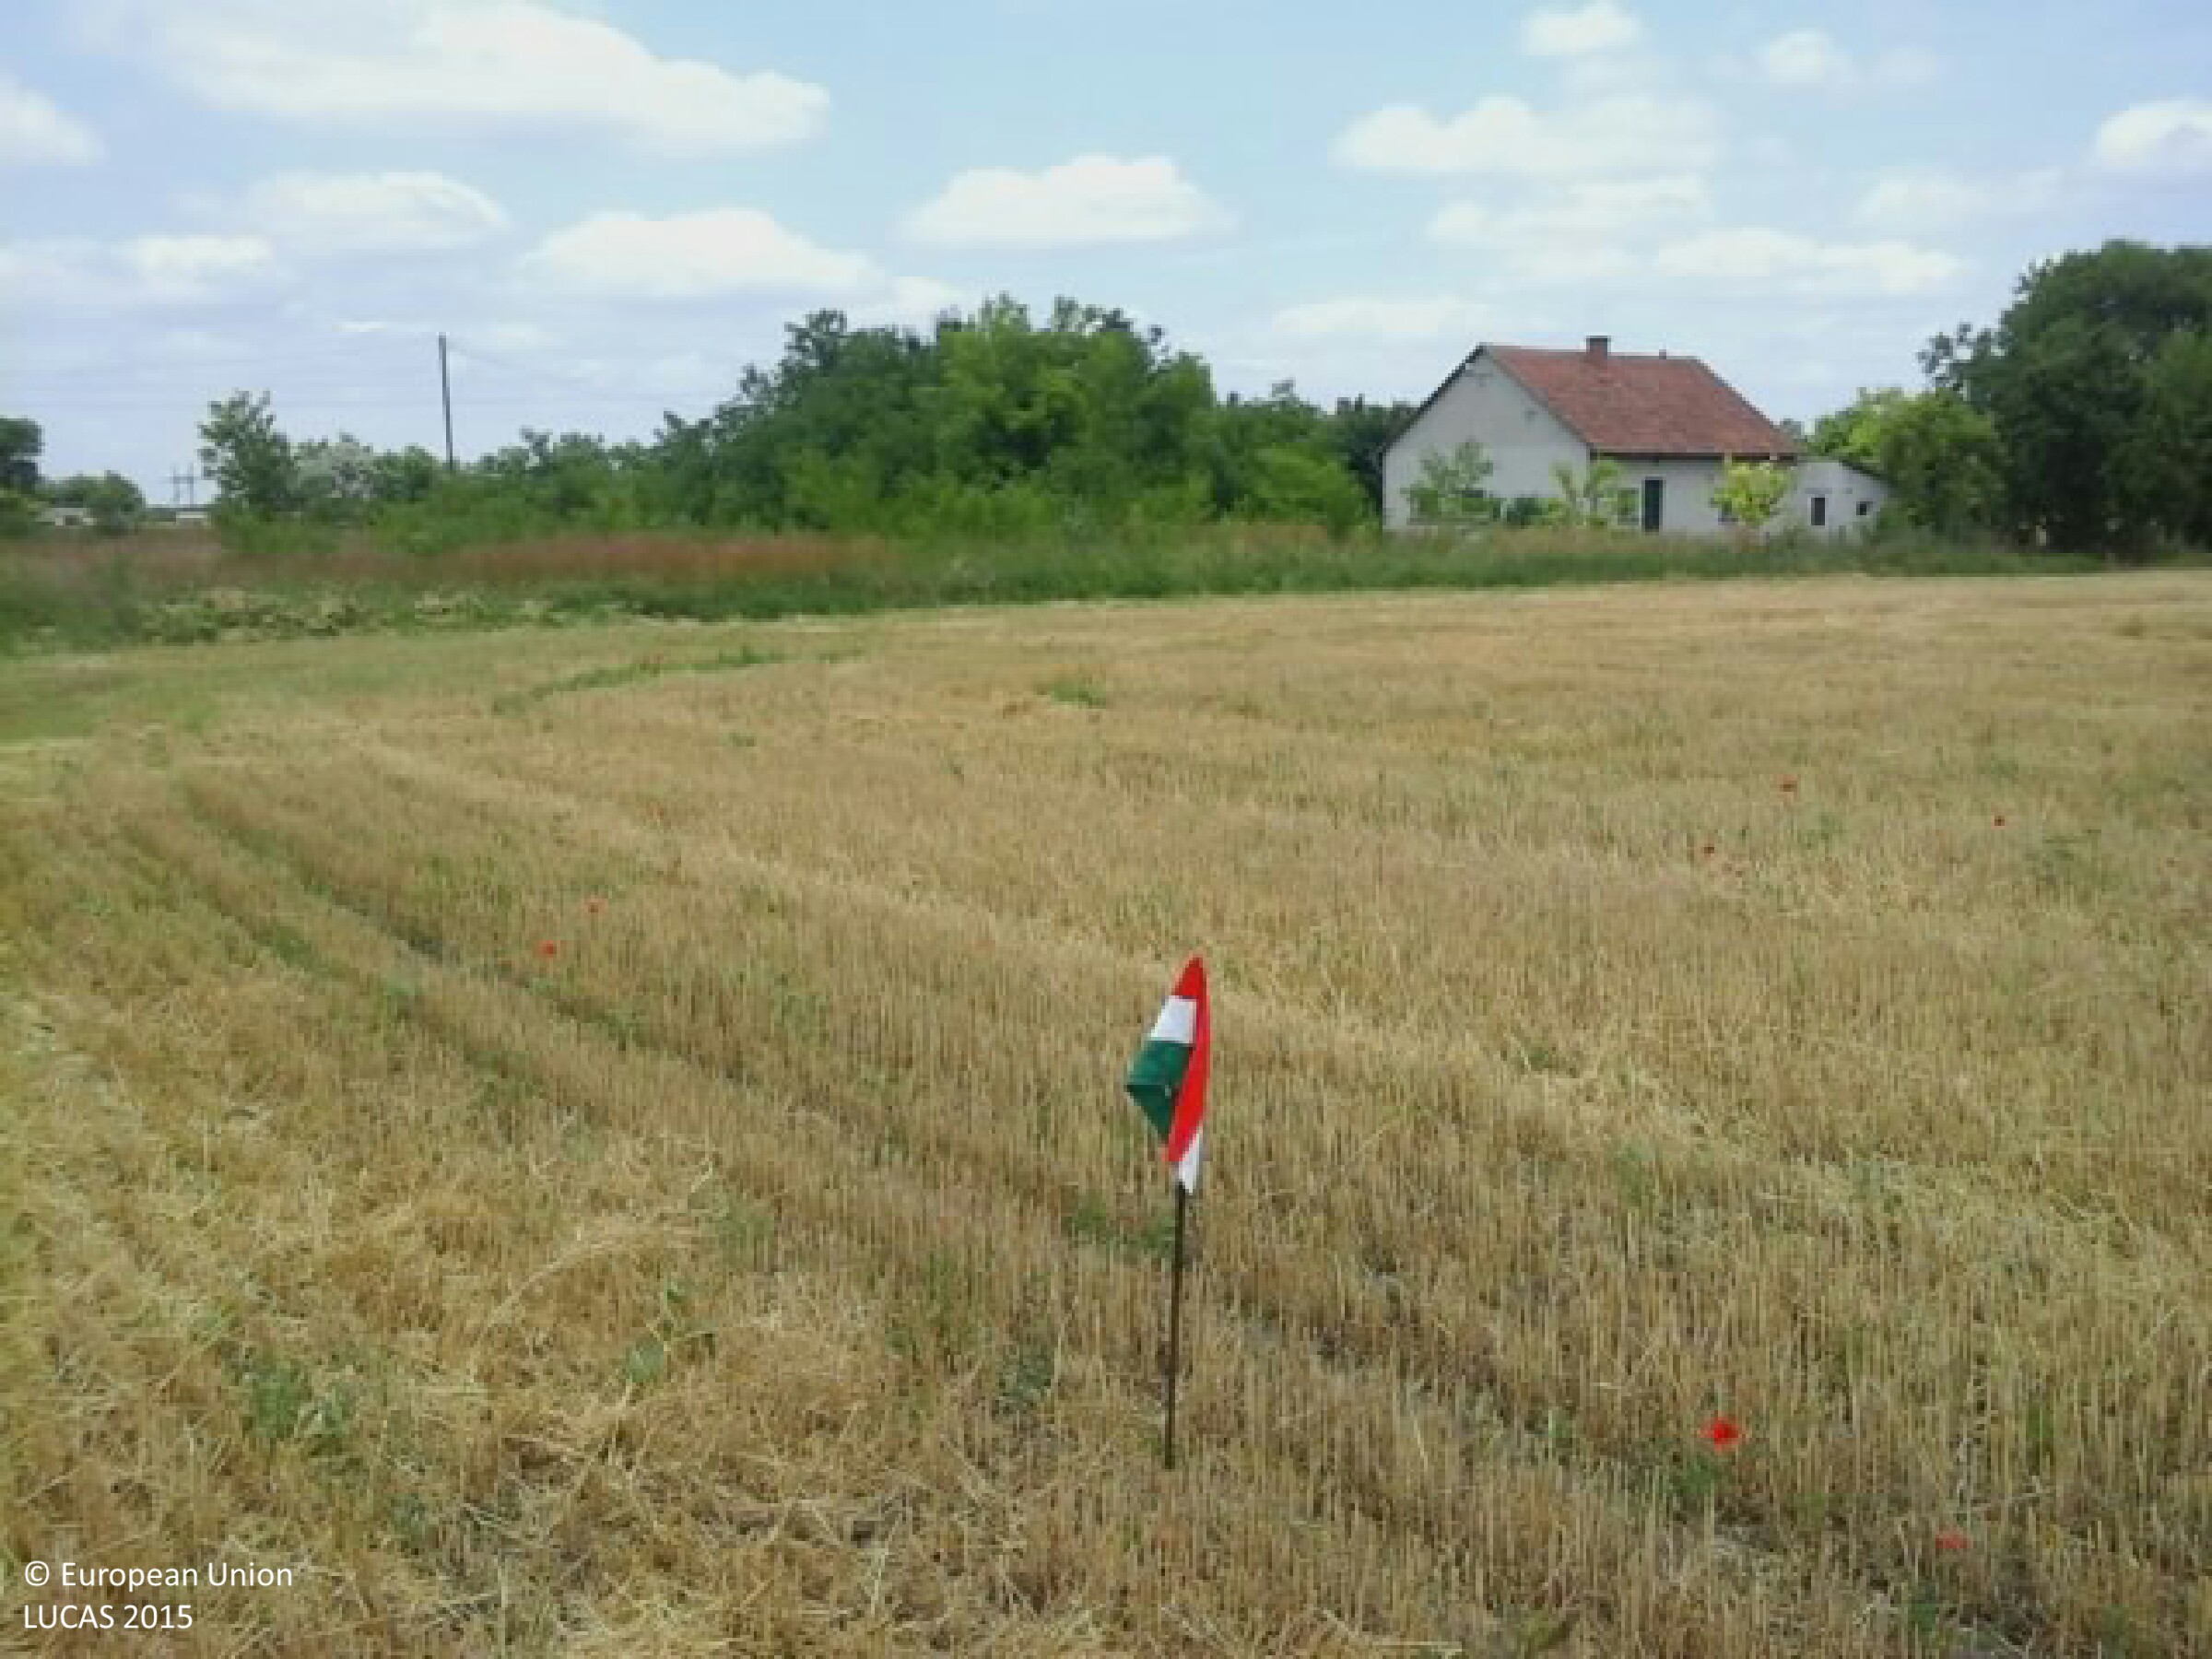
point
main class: Cropland
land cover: Barley
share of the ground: 50 - 75 %
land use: Agriculture (excluding fallow land and kitchen gardens)
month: June
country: HU
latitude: 46.2068
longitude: 20.0133
